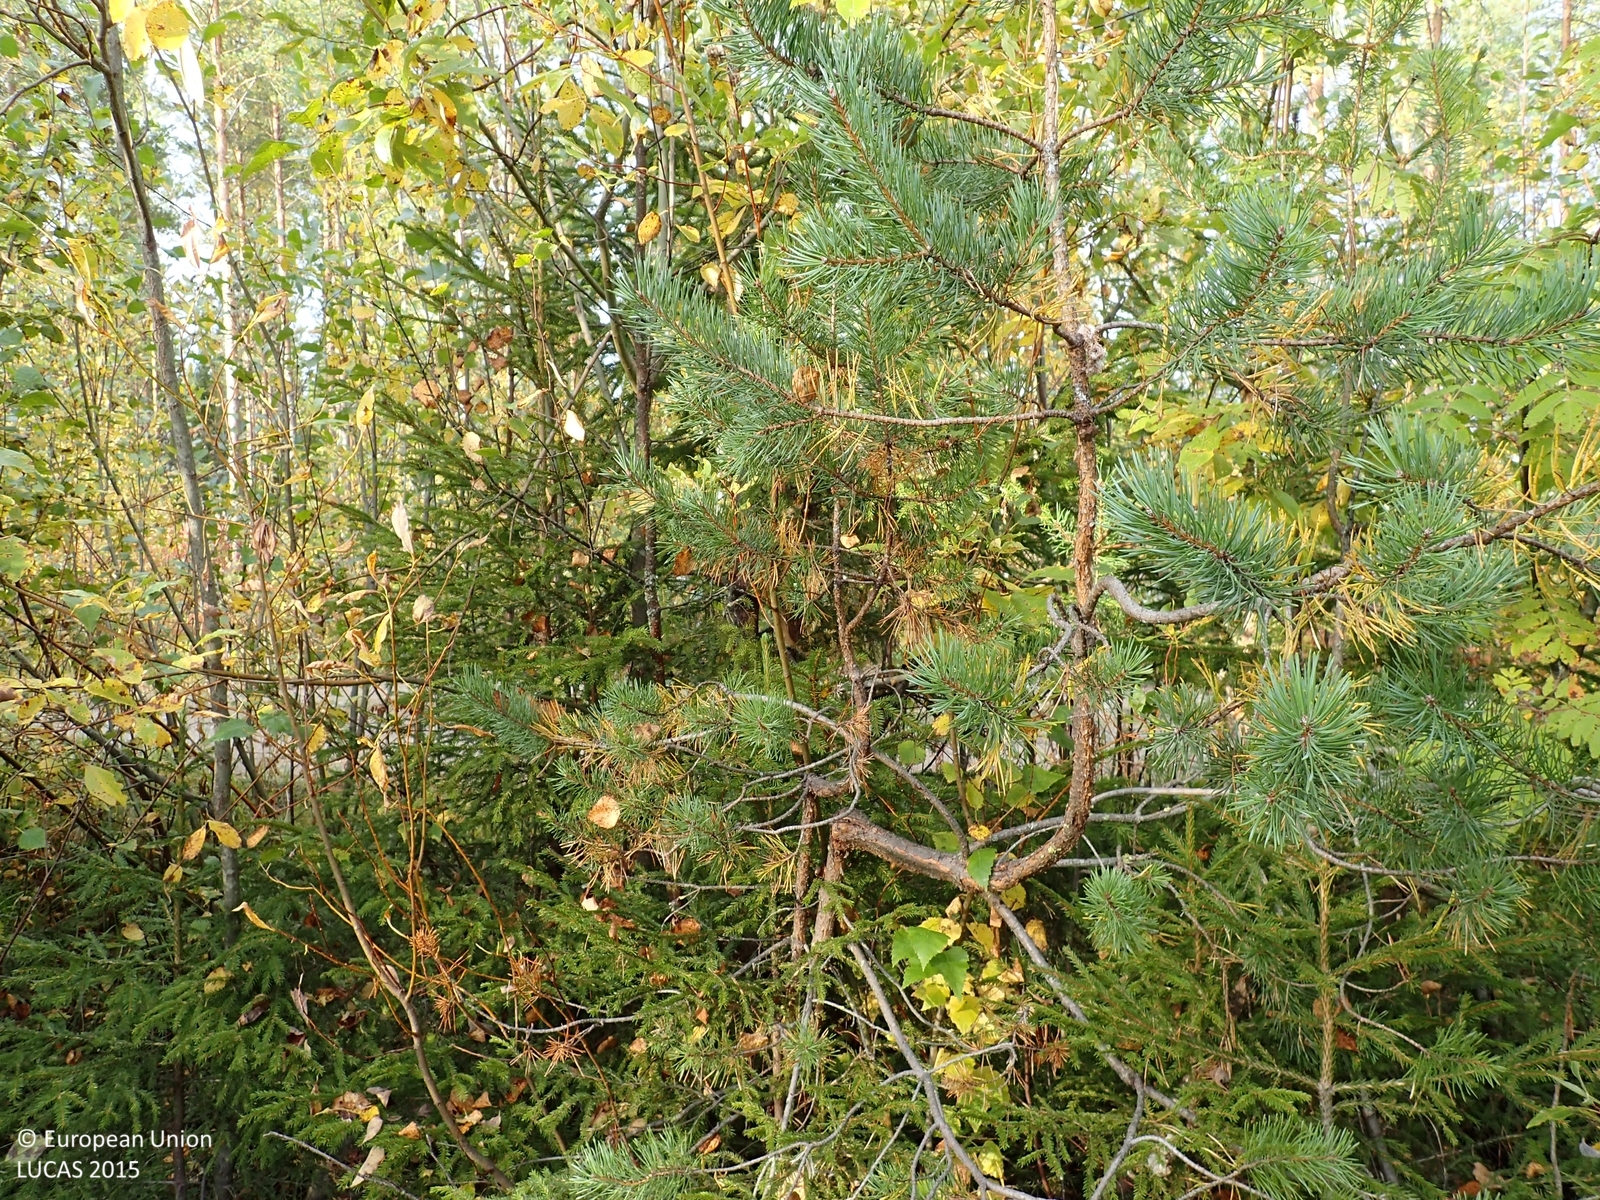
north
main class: Woodland
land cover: Pine dominated mixed woodland
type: boreal forest
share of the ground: 50 - 75 %
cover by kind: shrubs 40 %, broadleaved forest trees 35 %, coniferous forest trees 15 %, lichens and mosses 5 %, consolidated bare surface 5 %
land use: Forestry
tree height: < 5 m
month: September
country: FI
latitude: 63.0316
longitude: 25.7464
